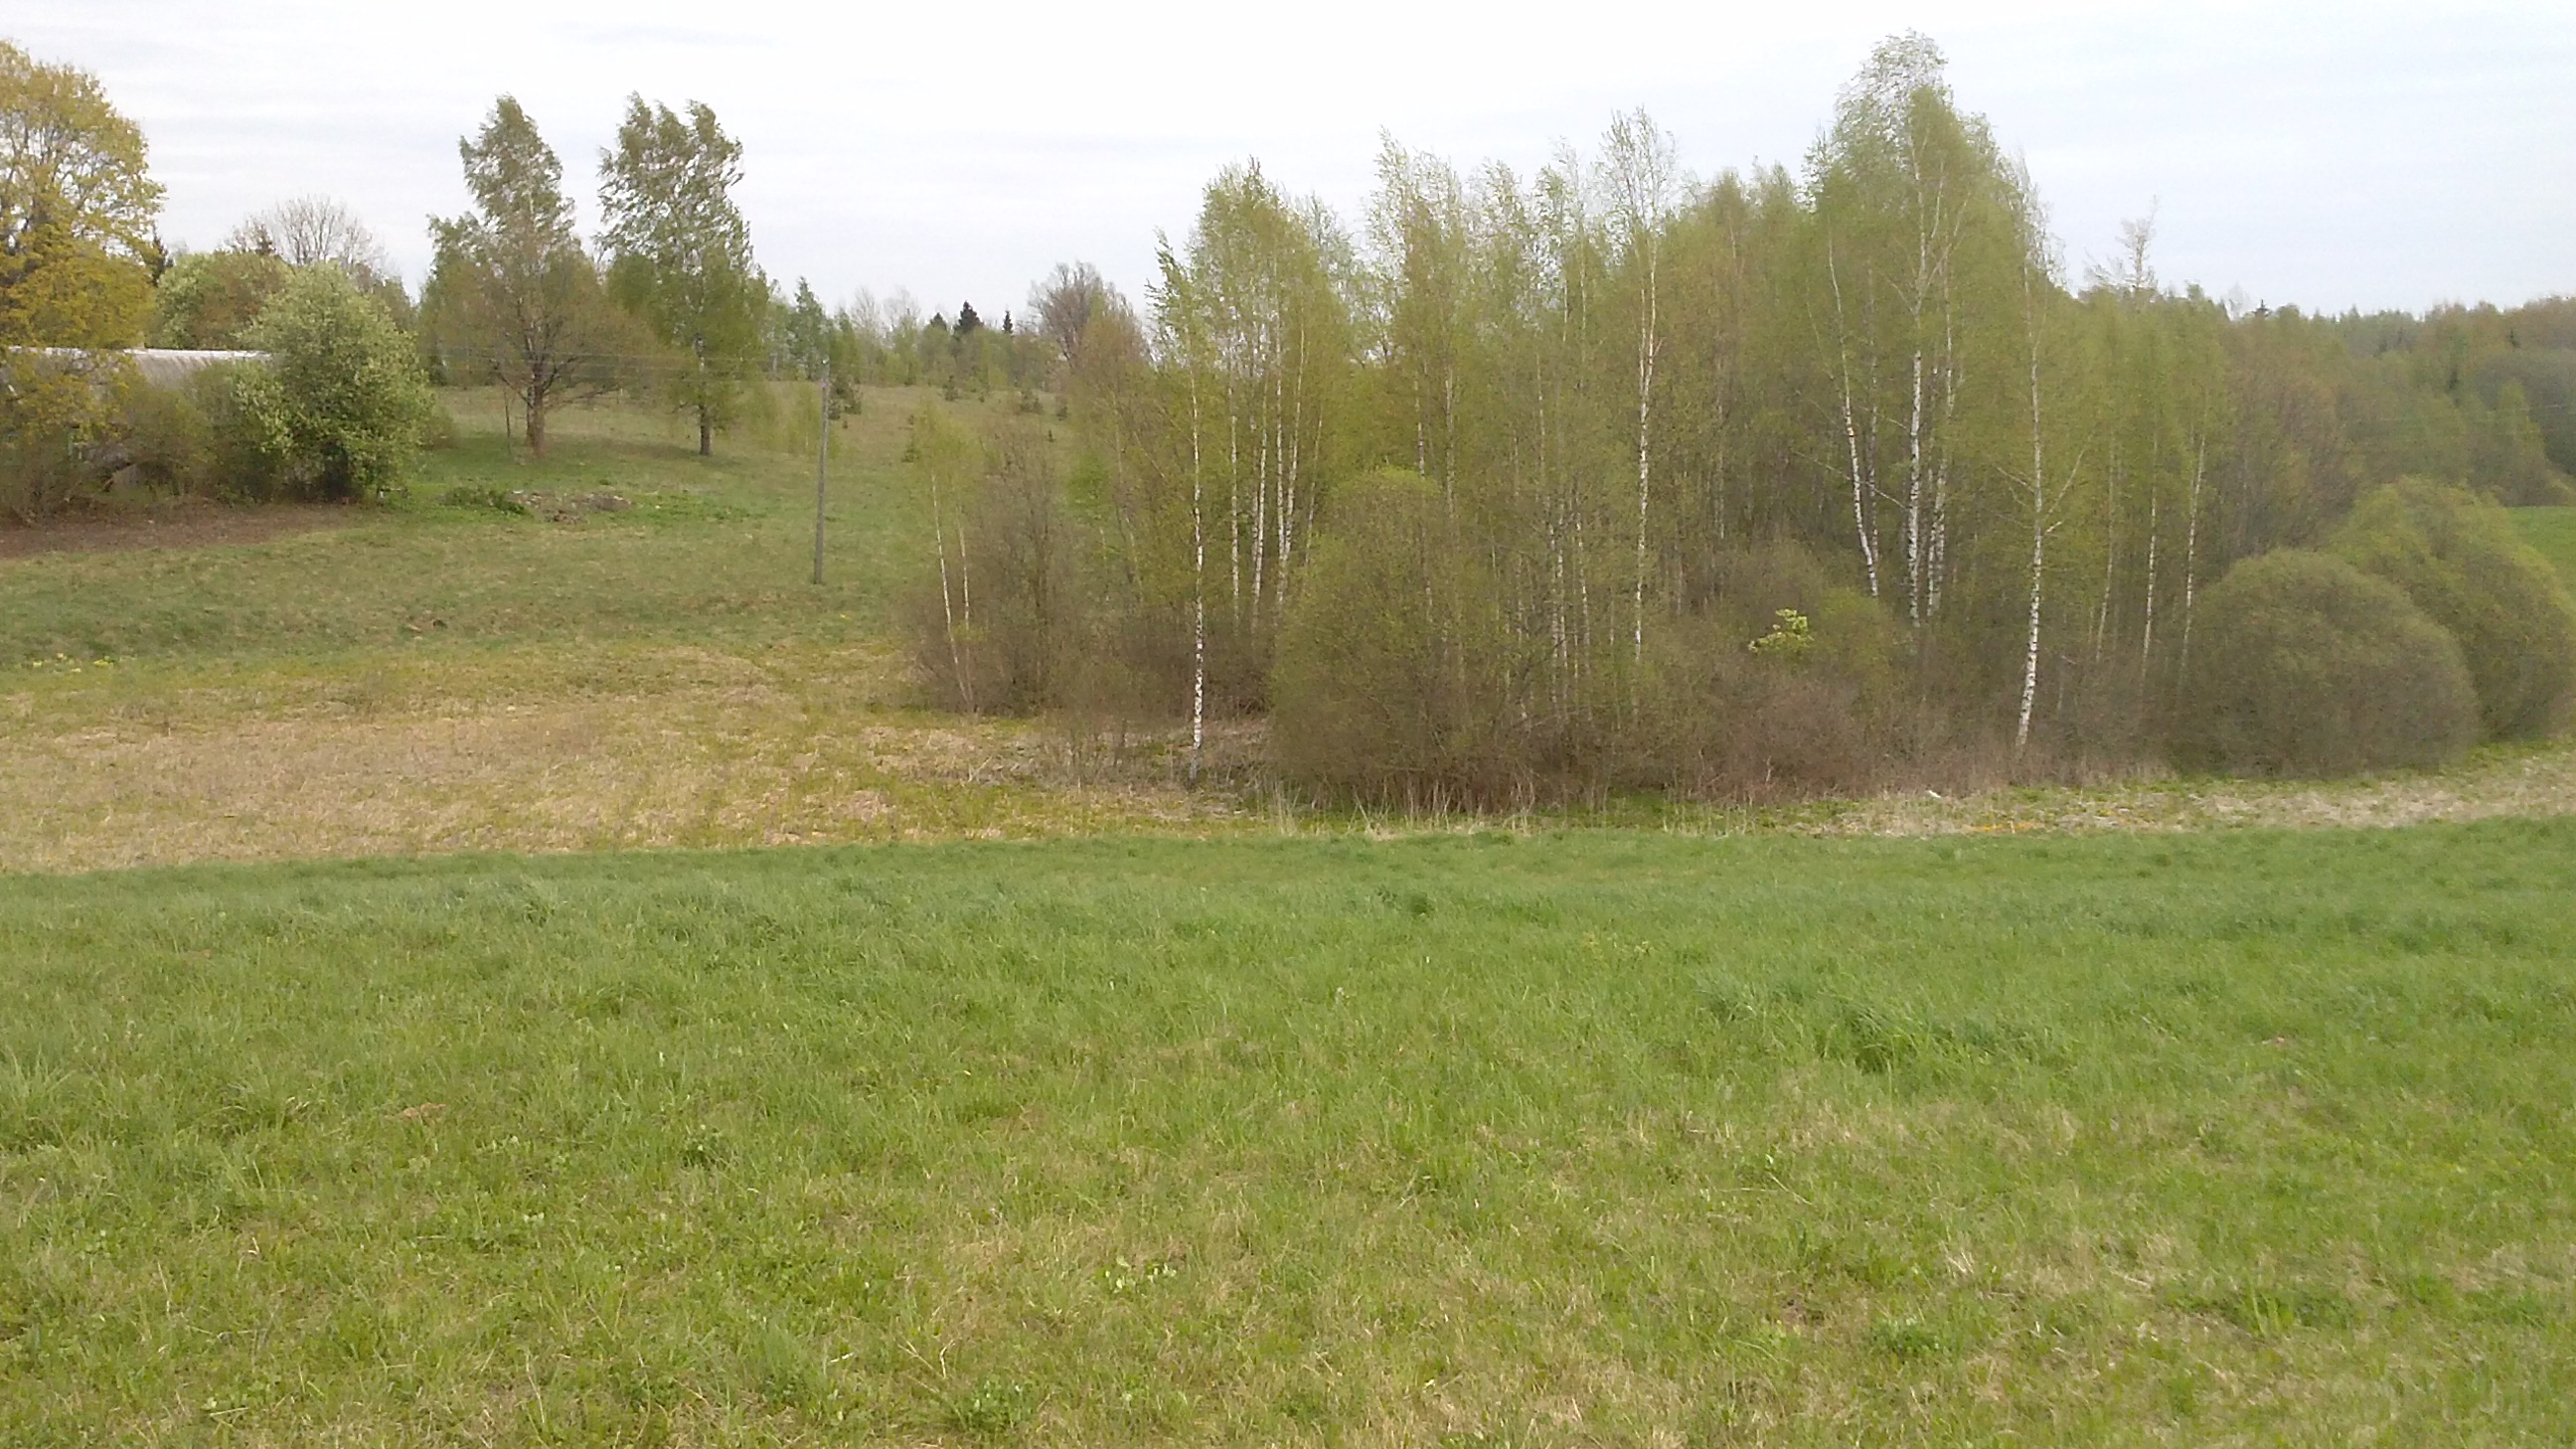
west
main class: Grassland
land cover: Grassland without tree/shrub cover
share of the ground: > 75 %
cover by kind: herbaceous plants 100 %
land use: Agriculture (excluding fallow land and kitchen gardens)
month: May
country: LV
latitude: 55.9579
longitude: 27.1652
